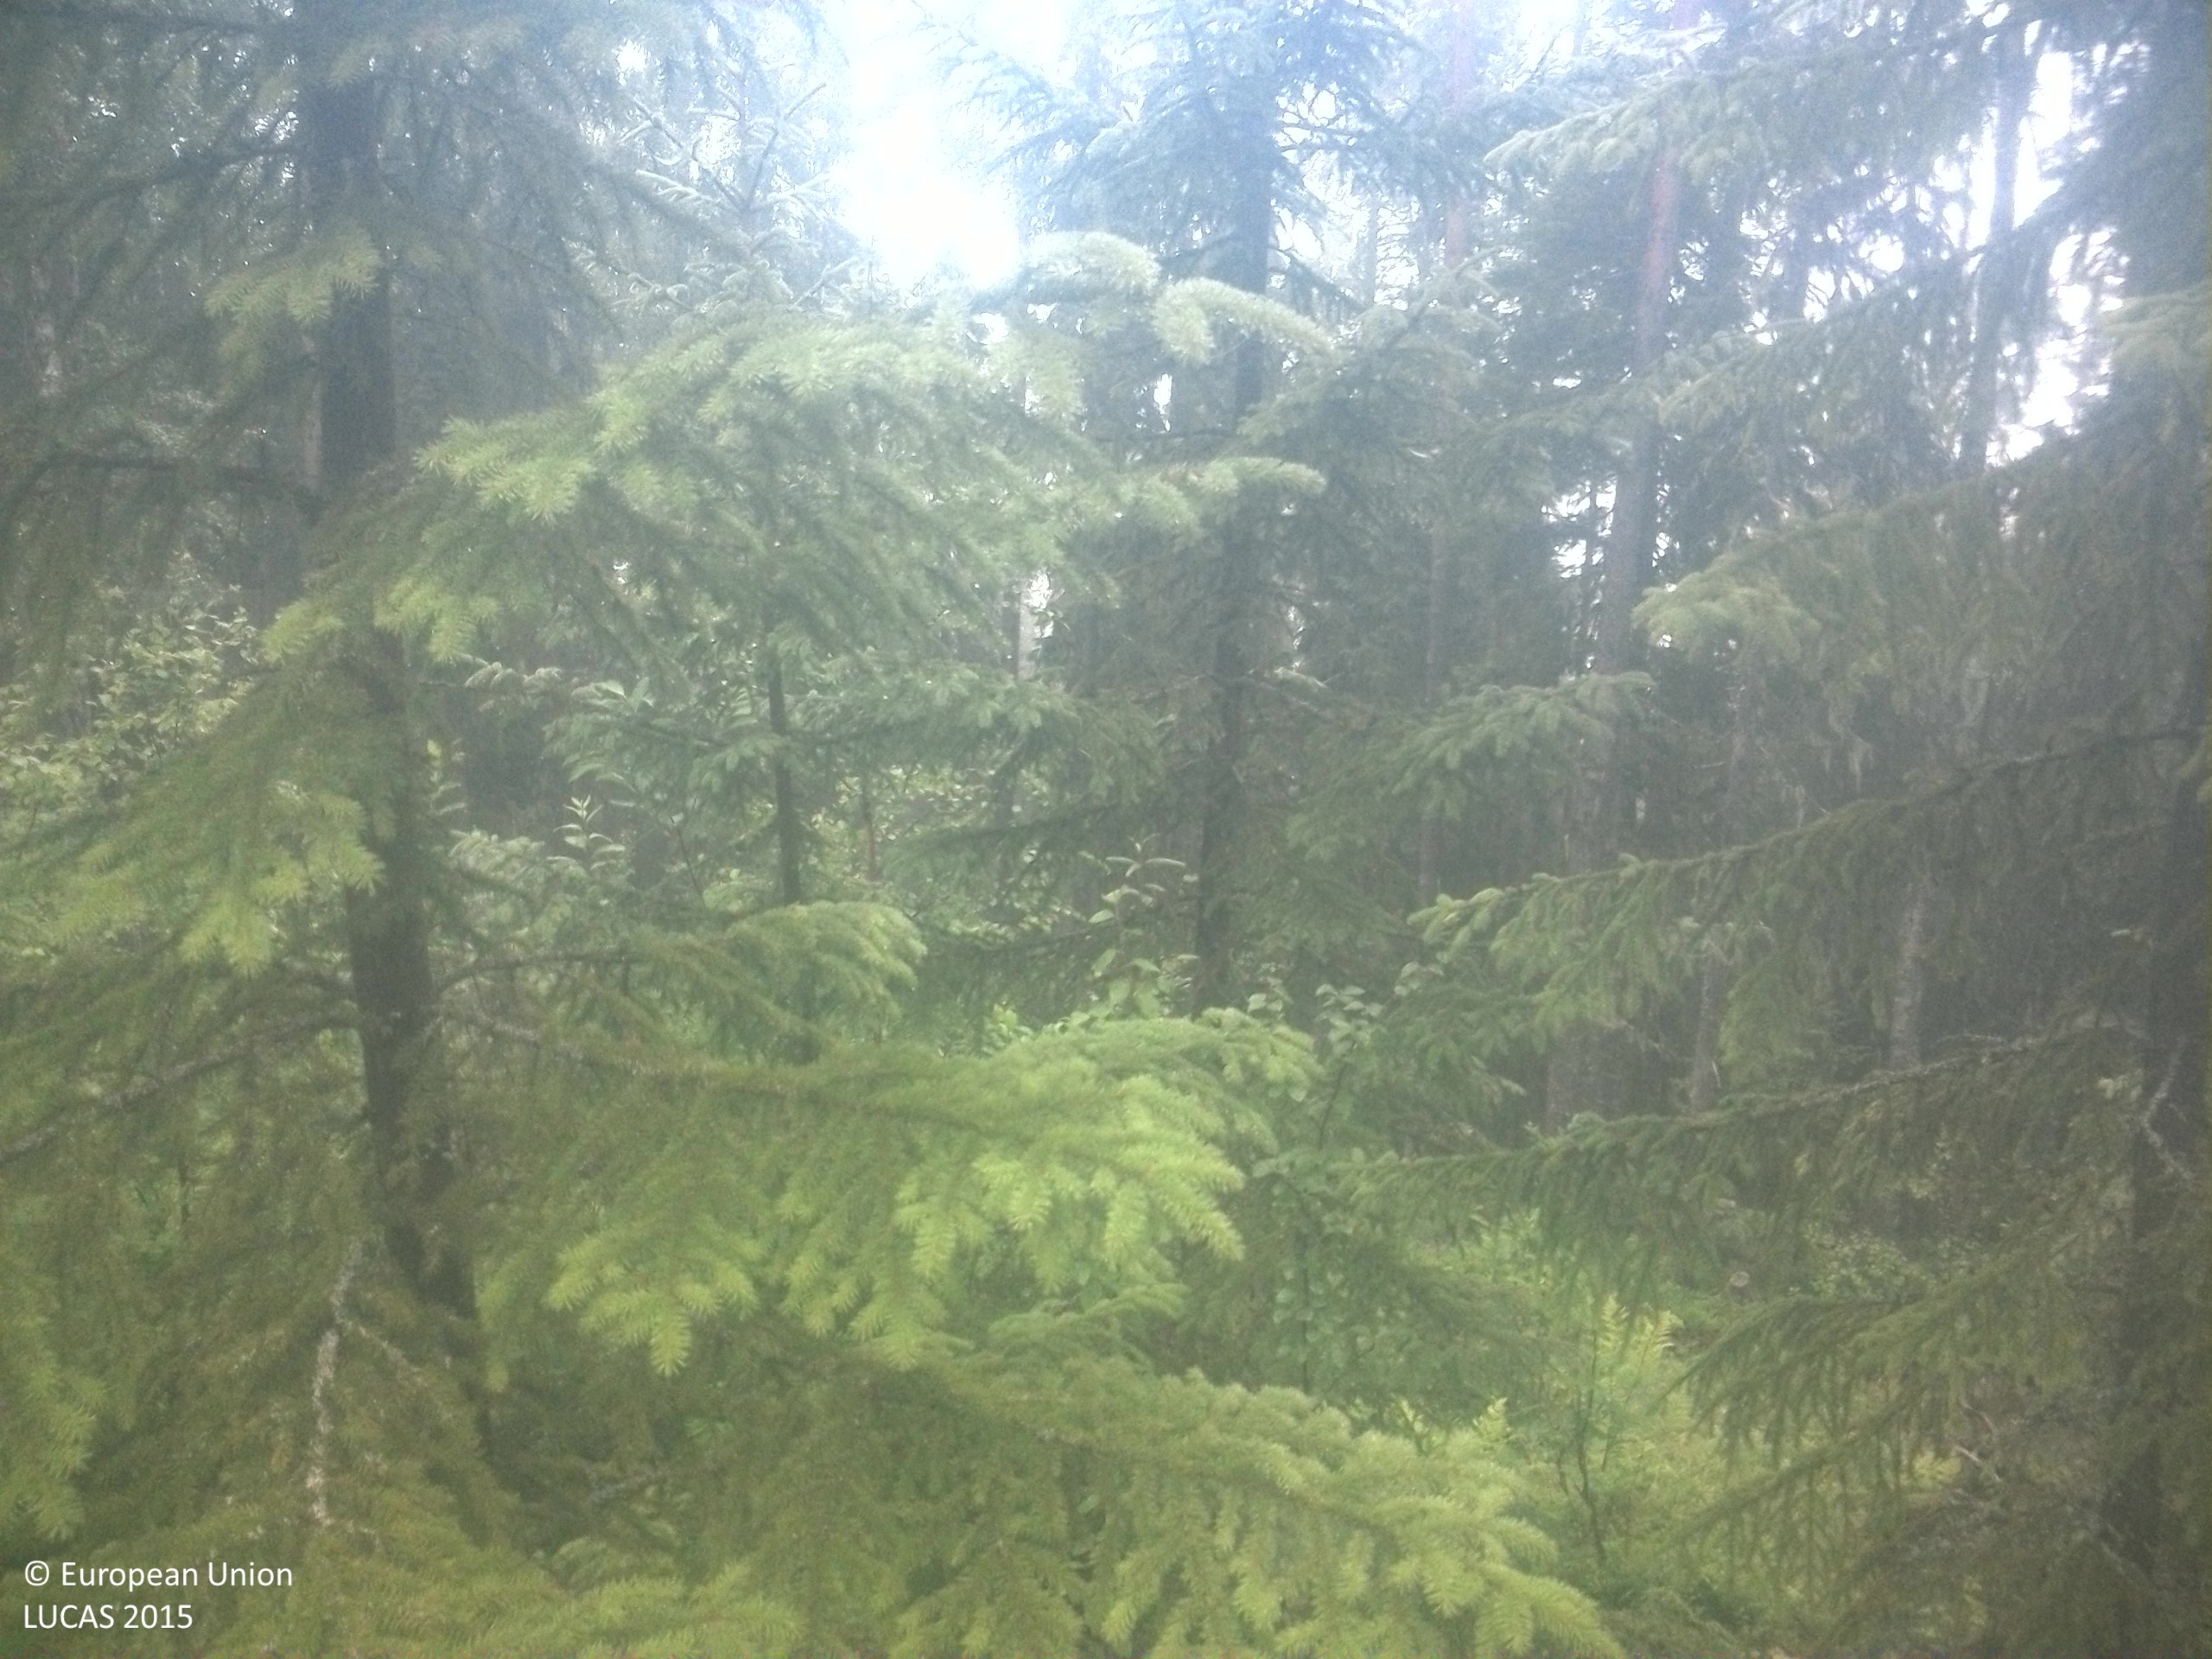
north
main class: Woodland
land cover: Spruce dominated mixed woodland
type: boreal forest
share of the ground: 50 - 75 %
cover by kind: coniferous forest trees 45 %, shrubs 20 %, broadleaved forest trees 15 %, lichens and mosses 10 %, herbaceous plants 5 %, consolidated bare surface 5 %
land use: Forestry
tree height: > 5 m
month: August
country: SE
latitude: 63.5431
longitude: 16.4315
